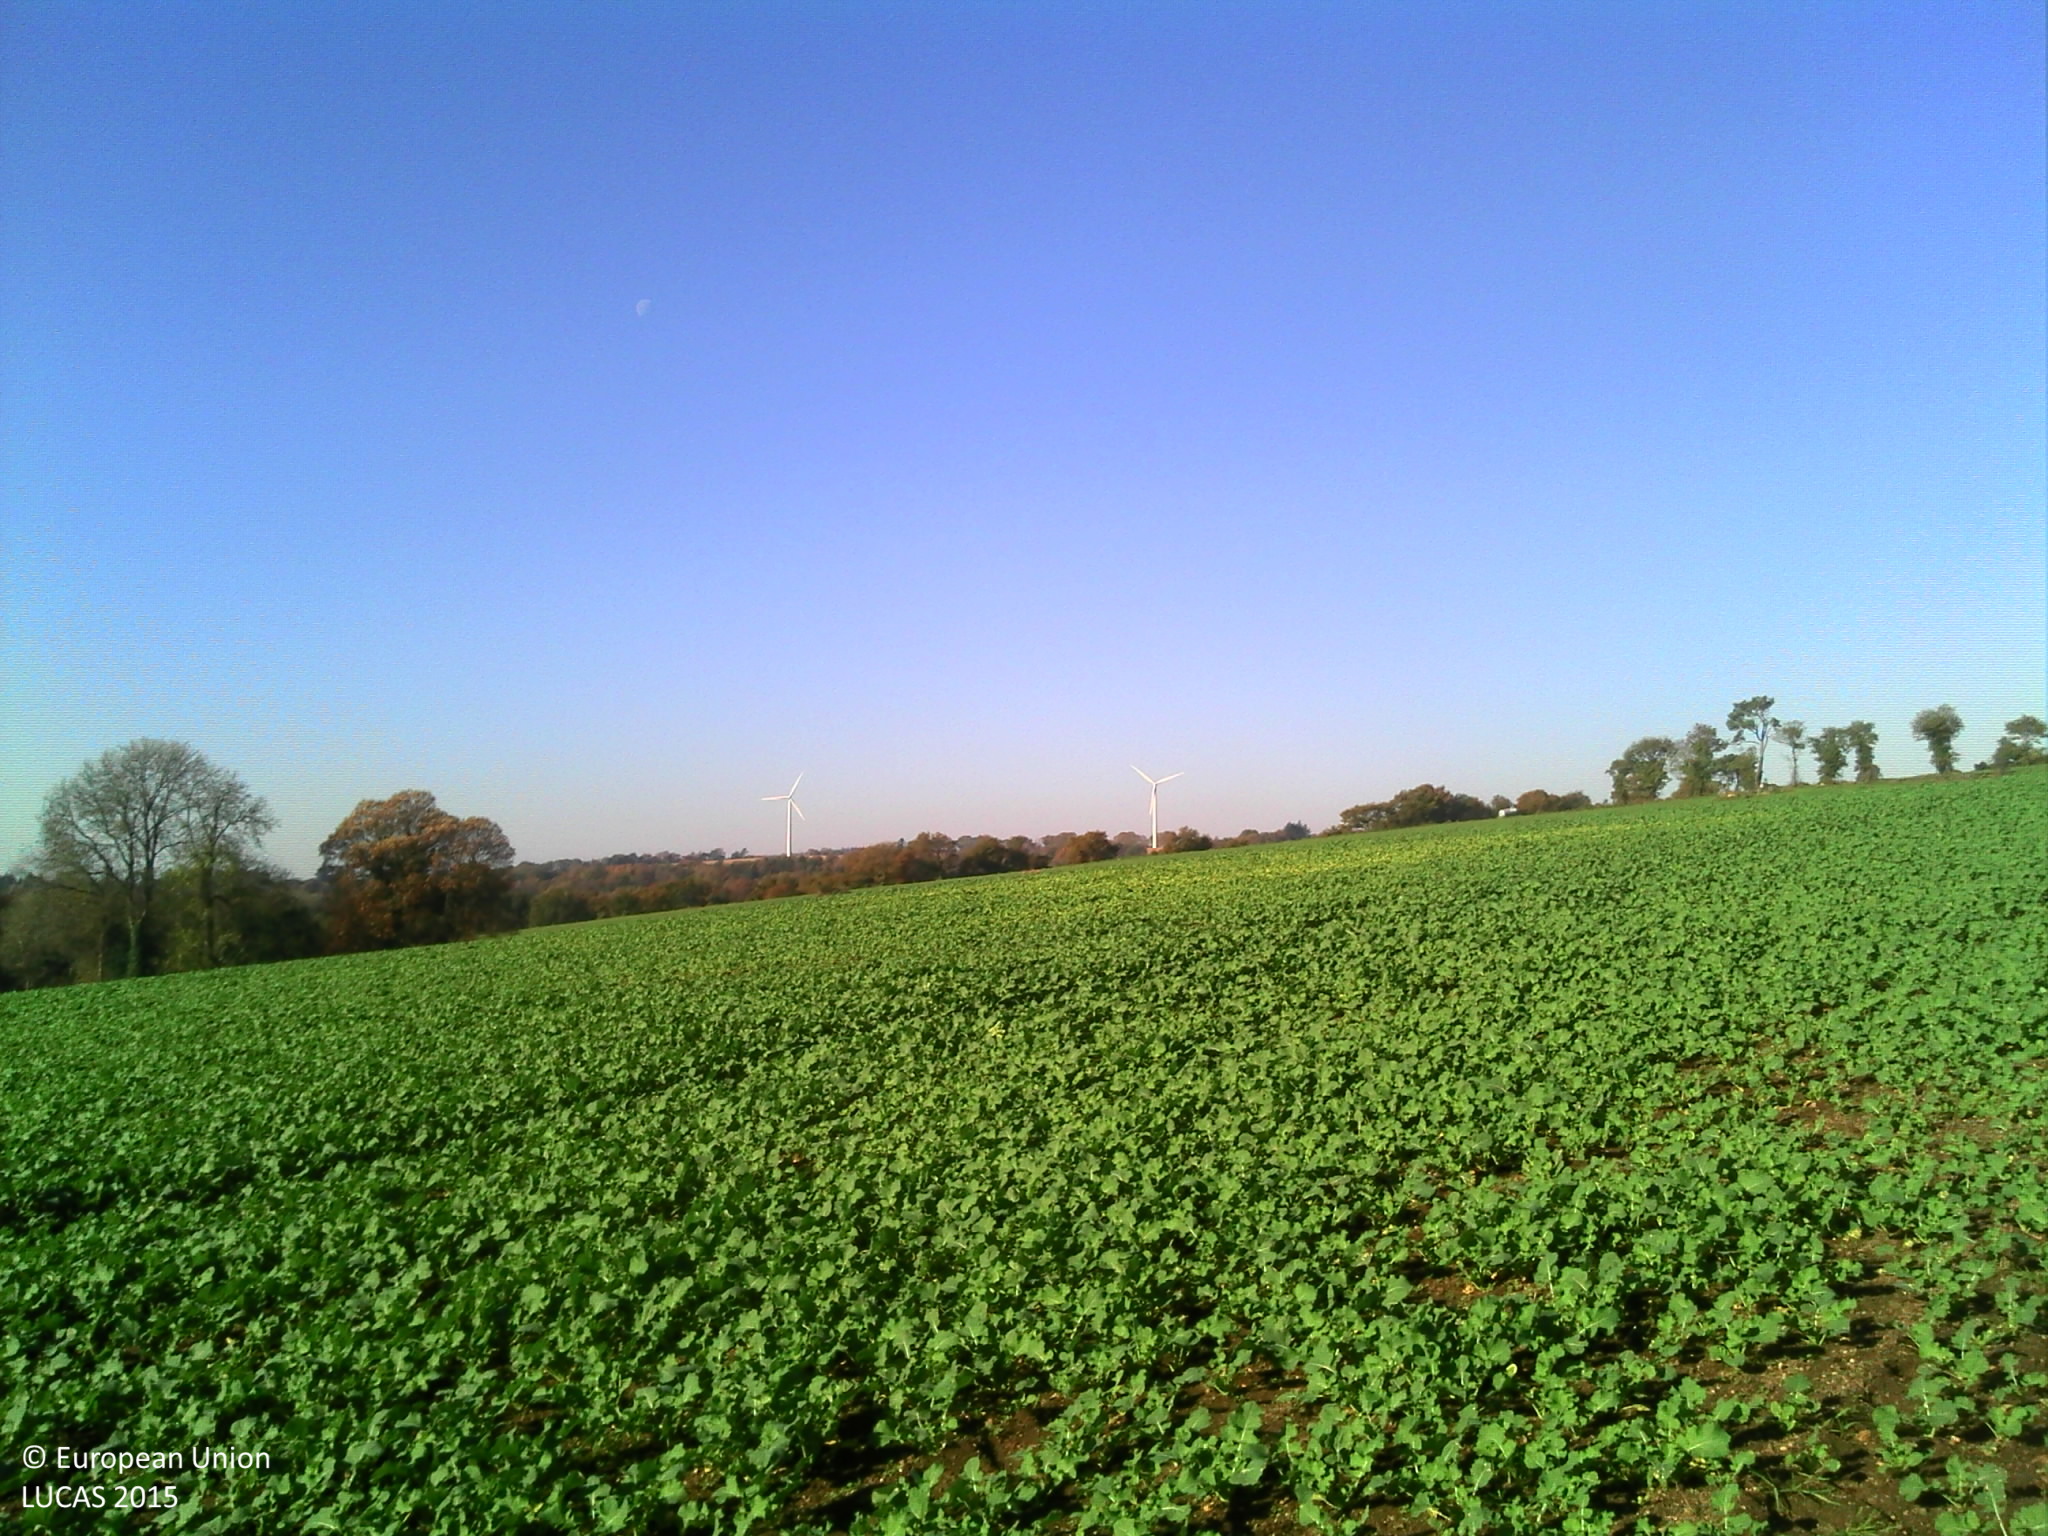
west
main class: Cropland
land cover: Rape and turnip rape
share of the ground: > 75 %
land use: Agriculture (excluding fallow land and kitchen gardens)
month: November
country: FR
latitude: 48.1365
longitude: -3.2008
